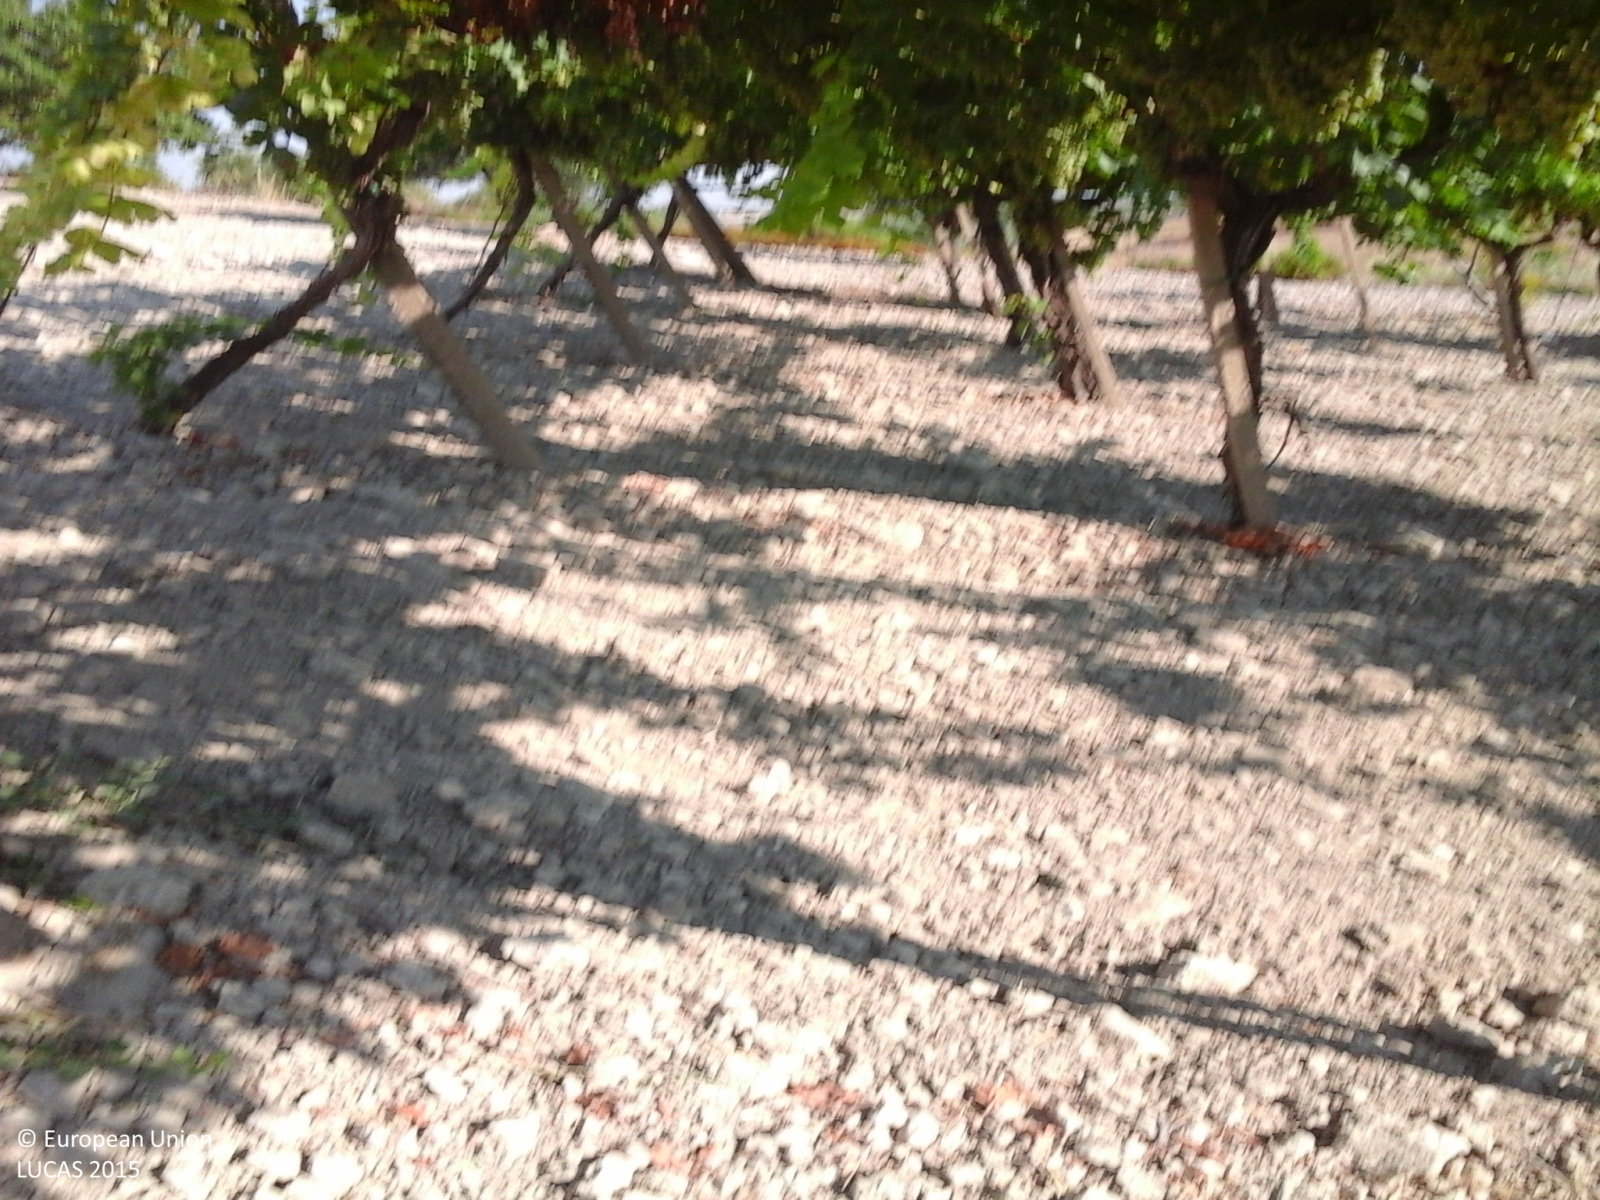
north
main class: Cropland
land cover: Vineyards
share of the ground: > 75 %
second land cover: Other bare soil
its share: > 75 %
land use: Agriculture (excluding fallow land and kitchen gardens)
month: July
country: IT
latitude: 37.2408
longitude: 14.1052
